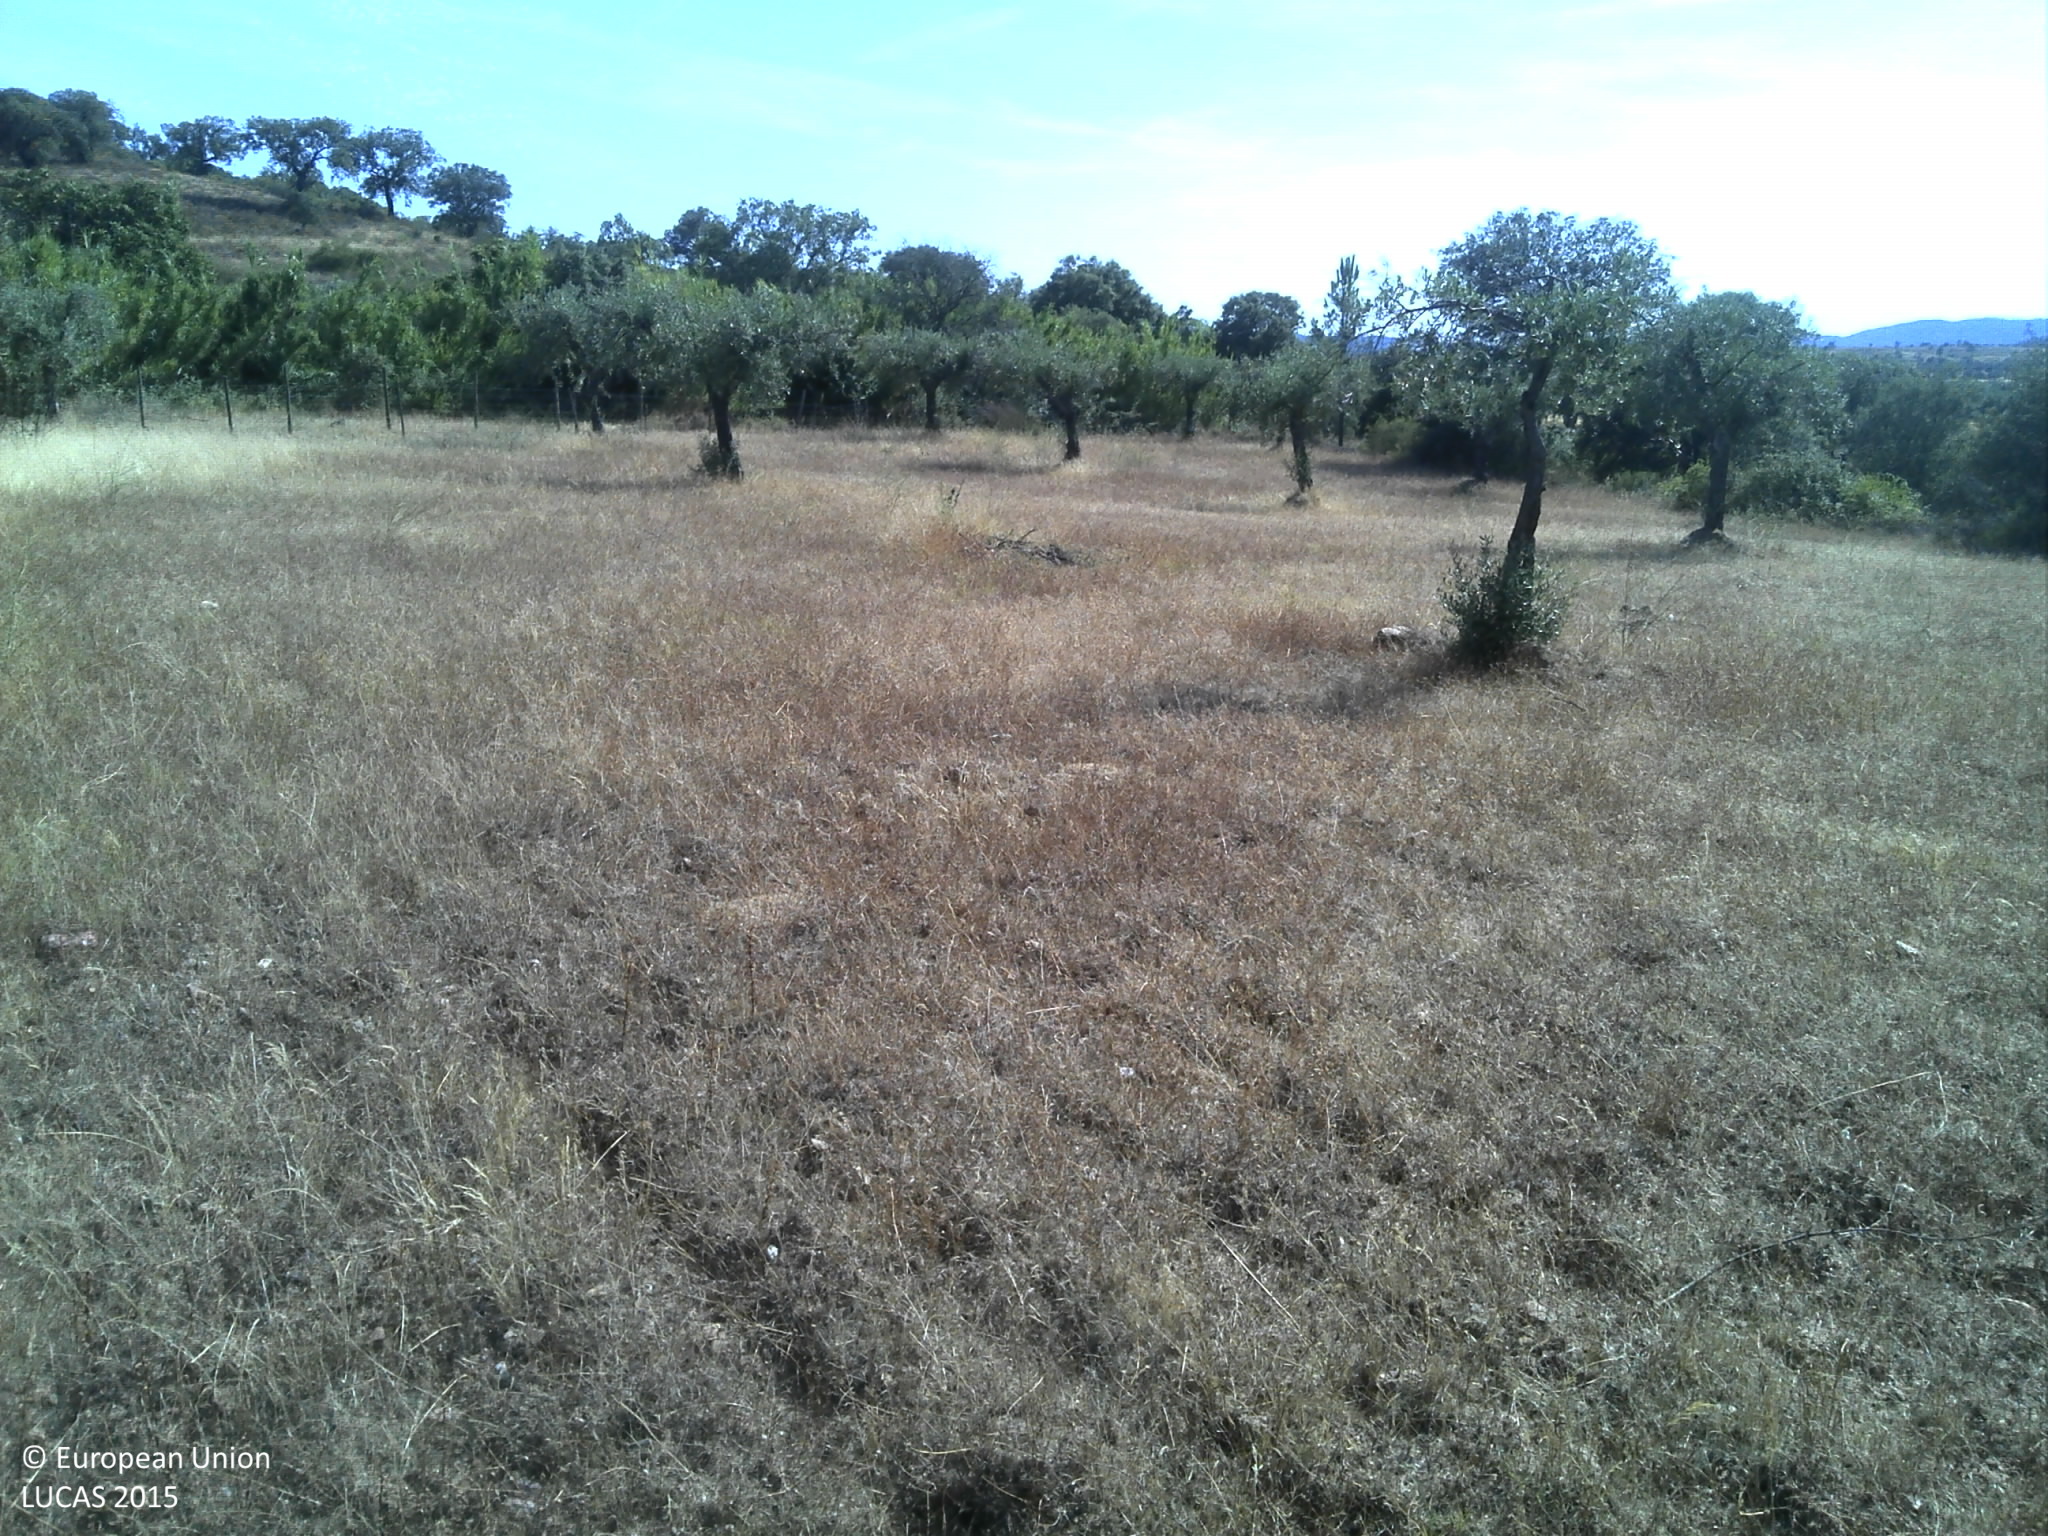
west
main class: Cropland
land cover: Olive groves
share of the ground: 25 - 50 %
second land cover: Grassland without tree/shrub cover
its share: 25 - 50 %
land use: Agriculture (excluding fallow land and kitchen gardens)
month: July
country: PT
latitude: 39.6996
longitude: -7.5808
